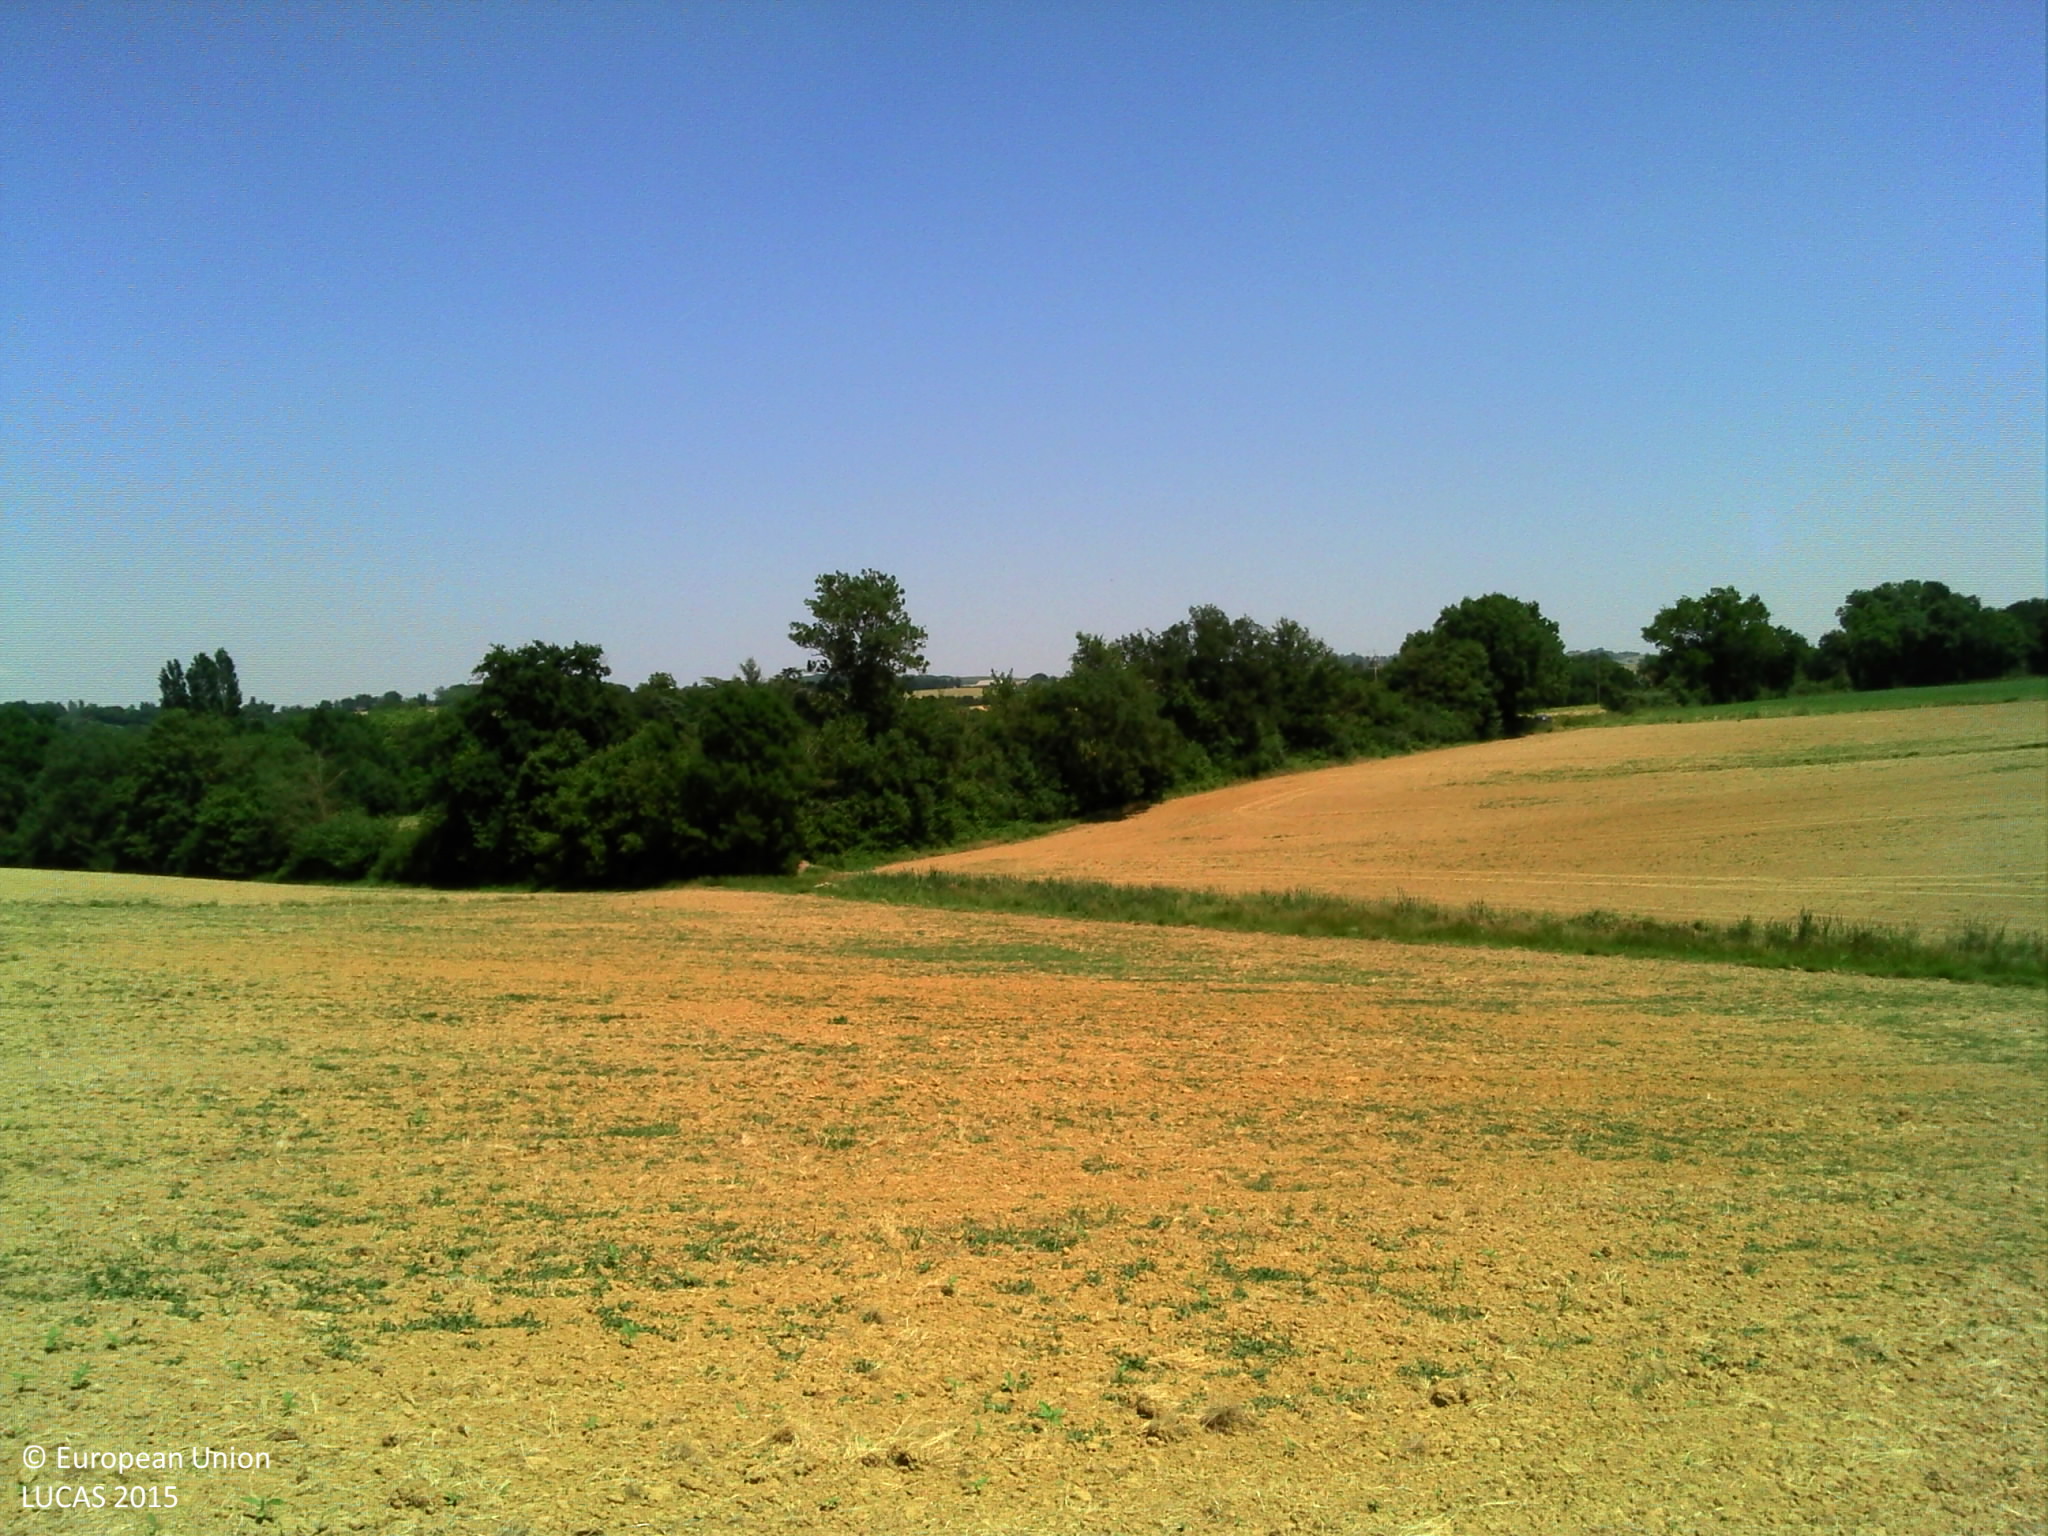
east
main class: Cropland
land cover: Sunflower
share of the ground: < 10 %
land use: Agriculture (excluding fallow land and kitchen gardens)
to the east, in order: Sunflower; Grass margins; Rivers and streams; Grass margins; Sunflower; Grass margins; Broadleaved woodland; Grass margins; Sunflower; Electric lines; Sunflower
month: June
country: FR
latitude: 43.7302
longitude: 0.6743
